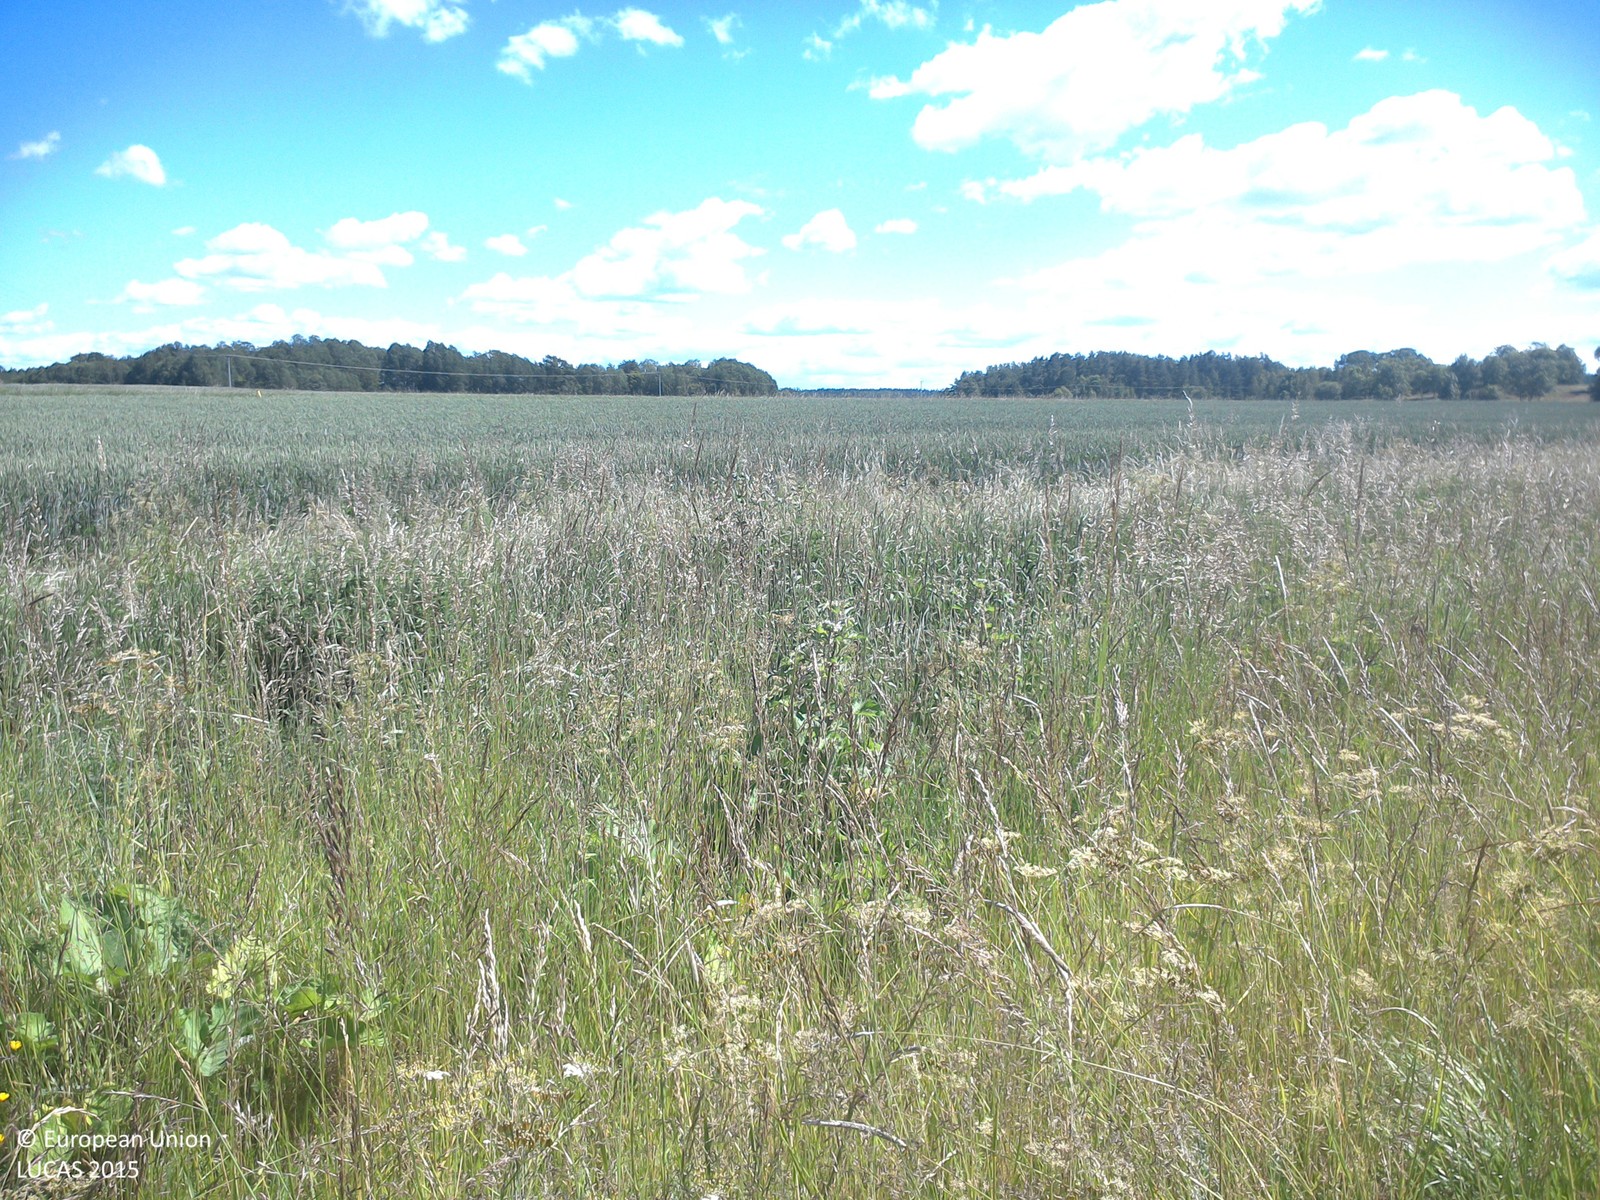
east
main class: Cropland
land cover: Common wheat
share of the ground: > 75 %
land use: Agriculture (excluding fallow land and kitchen gardens)
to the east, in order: Common wheat; Ditches and canals; Common wheat; Ditches and canals; Grass margins; Paved roads, cycling and walking lanes; Grass margins; Ditches and canals; Common wheat
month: July
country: SE
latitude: 58.3616
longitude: 15.4468
